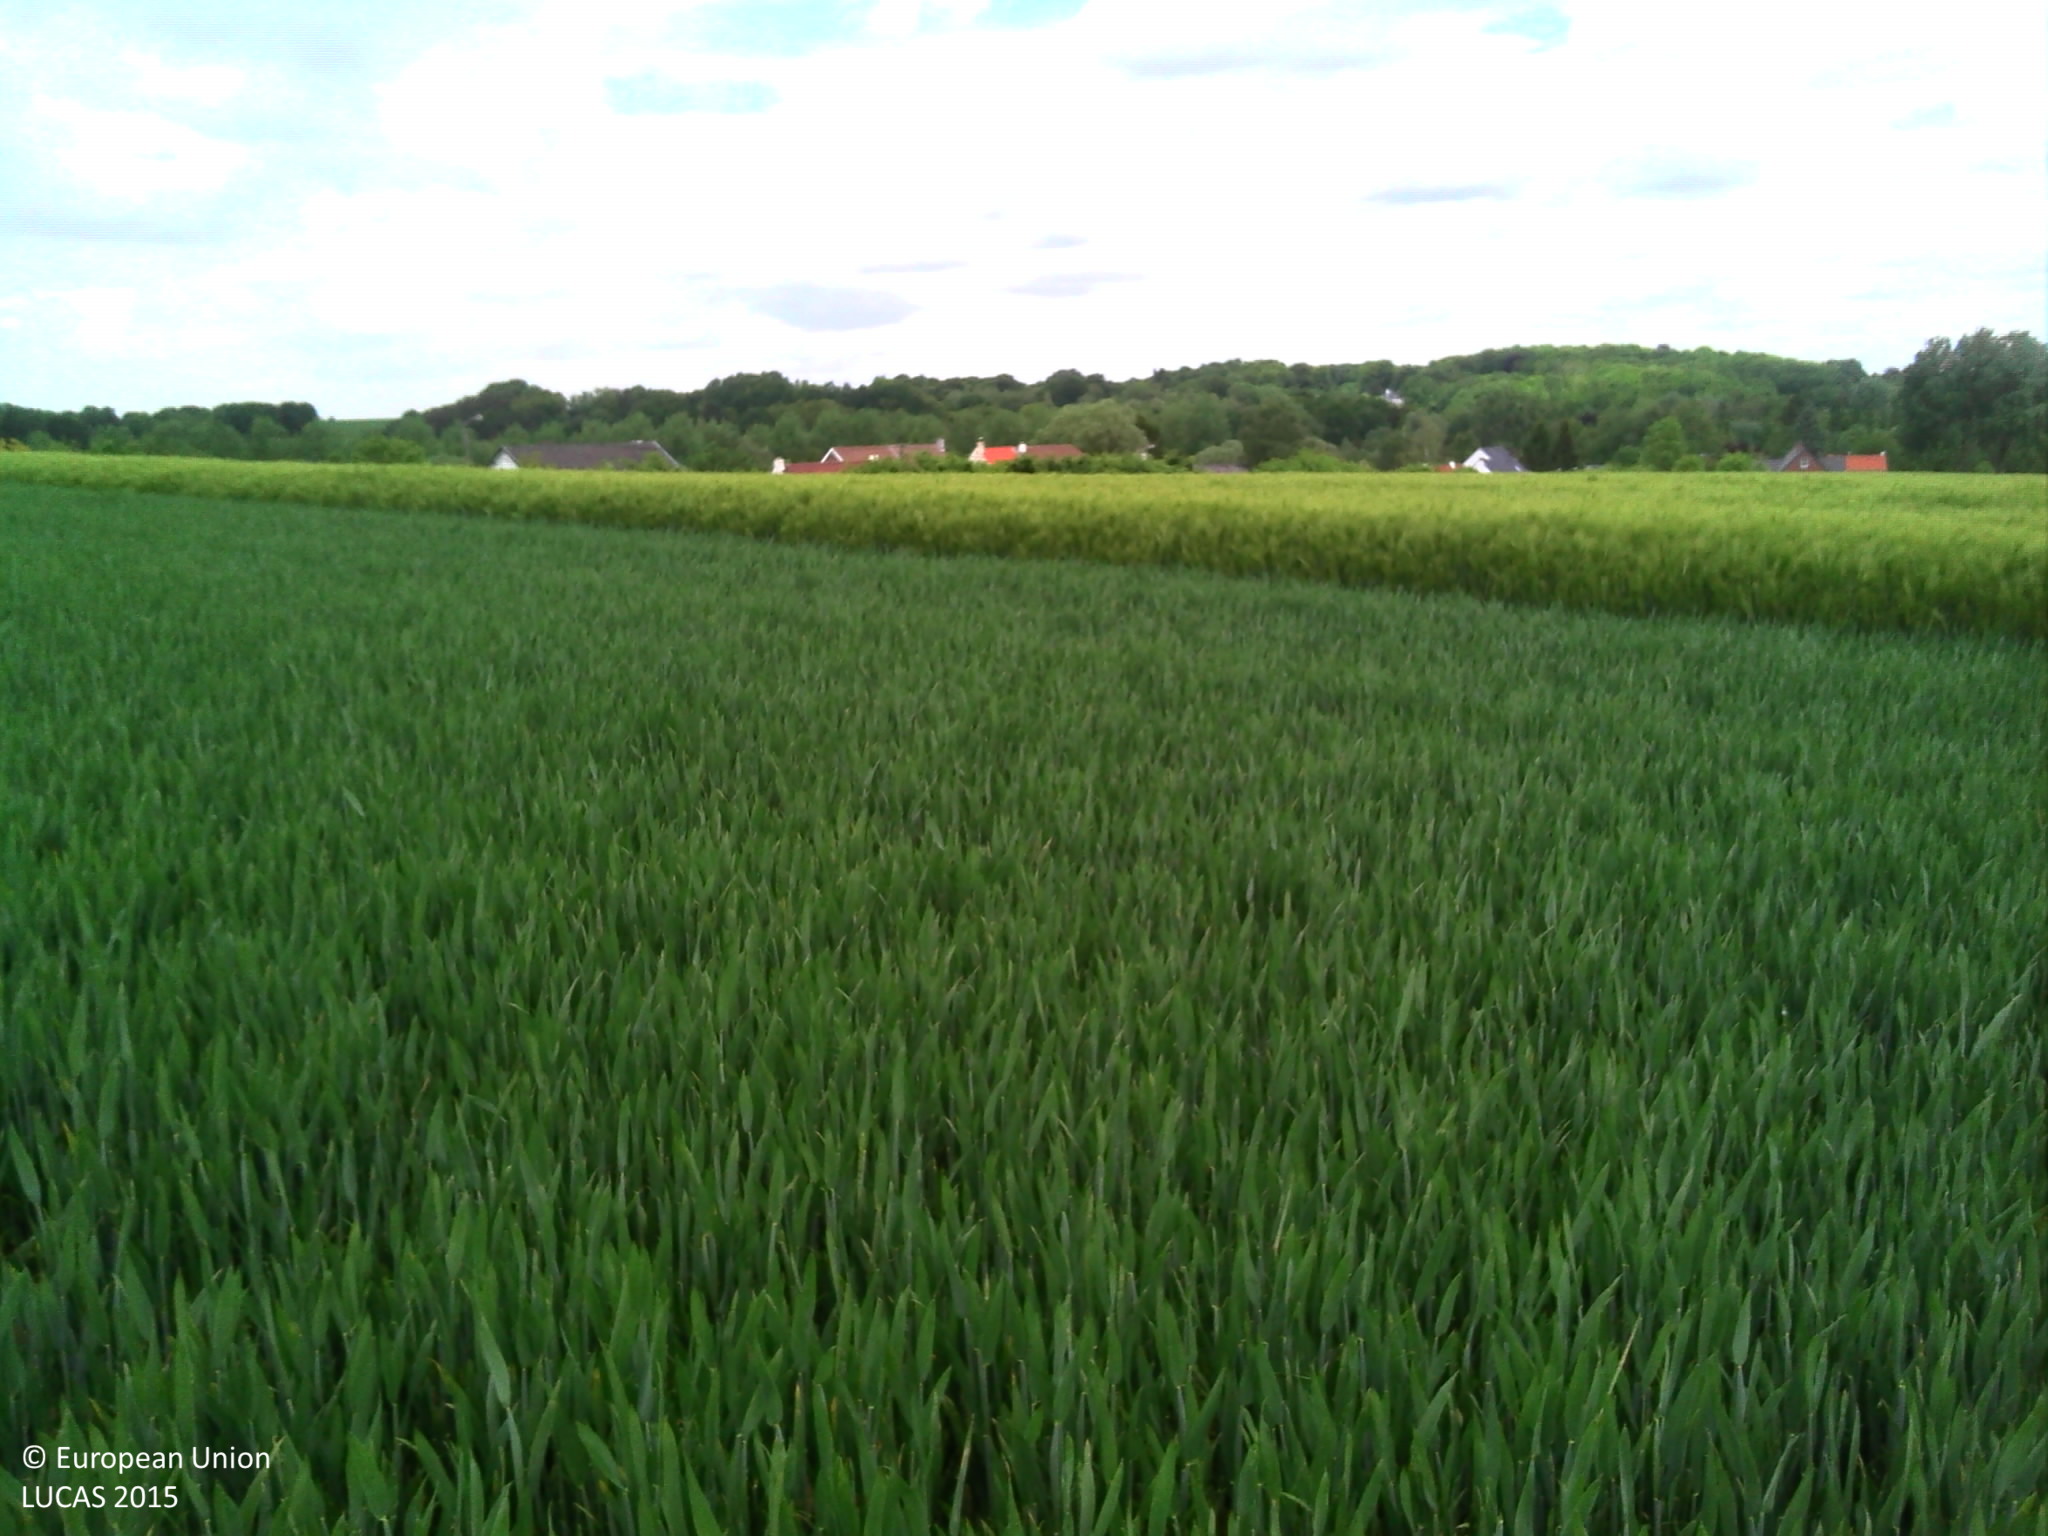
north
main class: Cropland
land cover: Common wheat
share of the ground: > 75 %
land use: Agriculture (excluding fallow land and kitchen gardens)
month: May
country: BE
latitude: 50.6626
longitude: 4.4642
